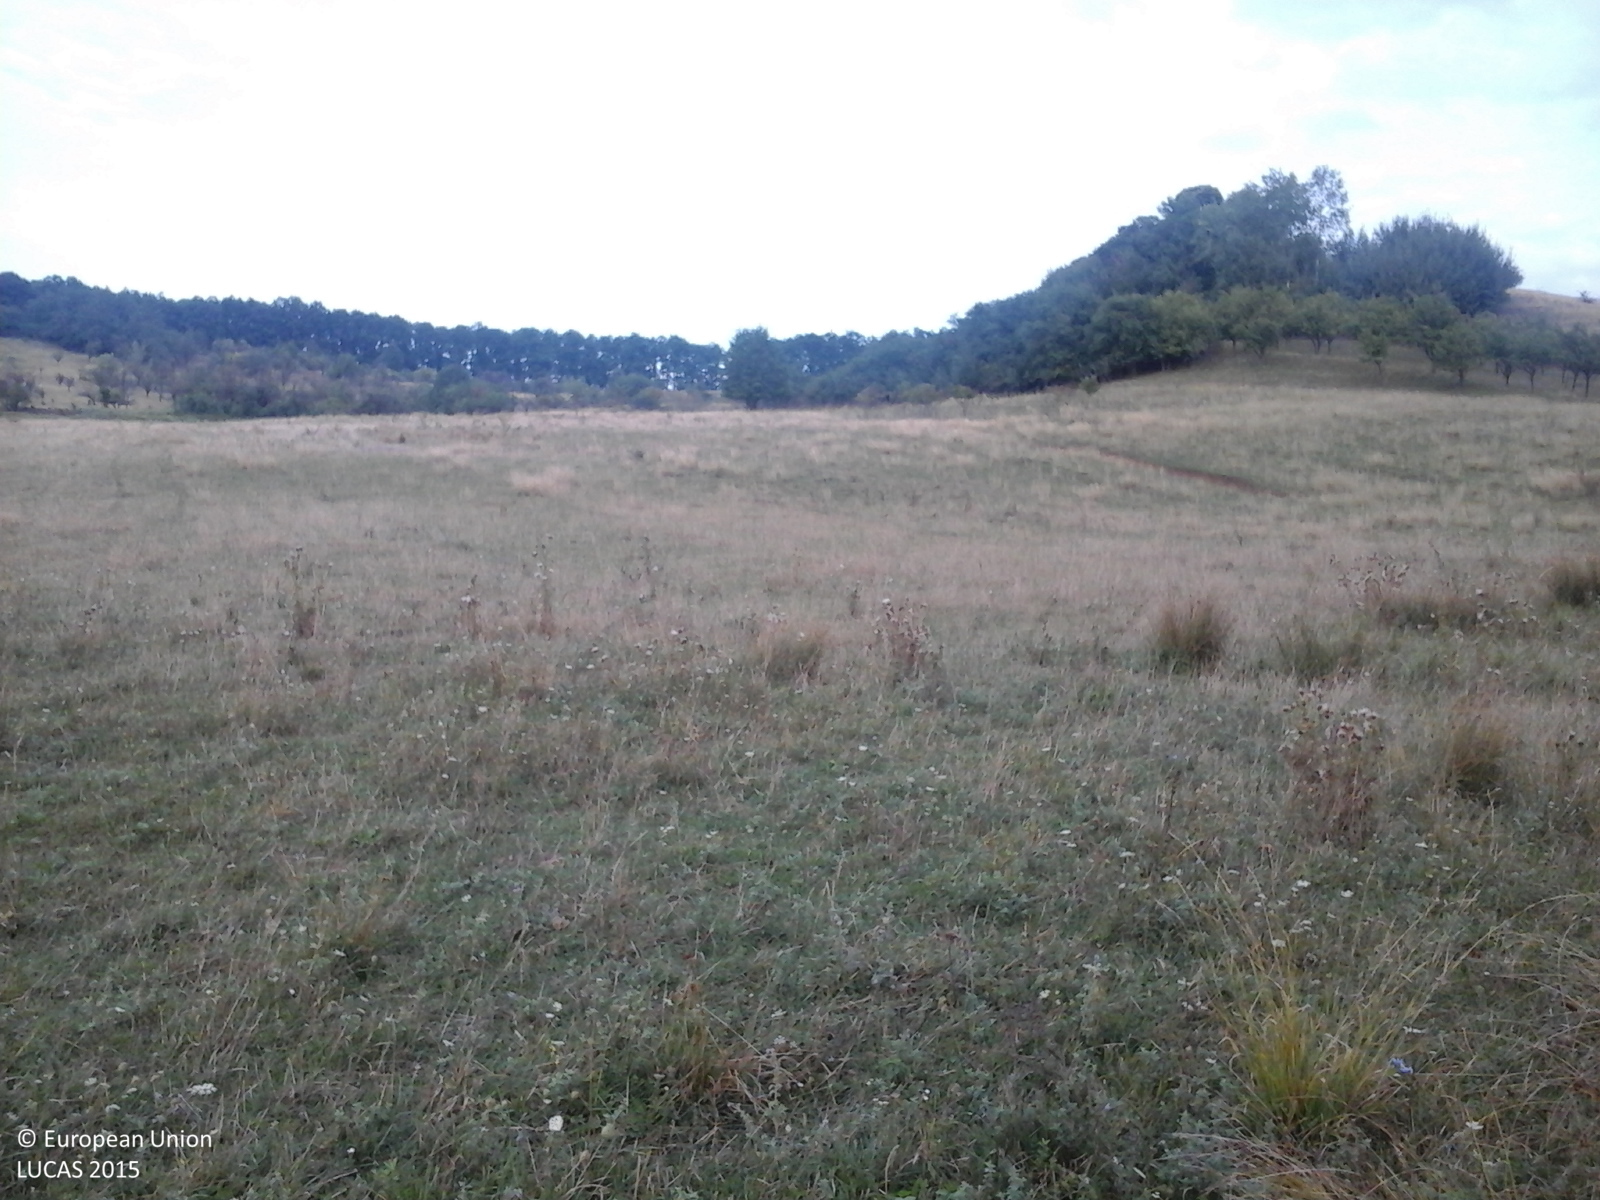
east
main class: Grassland
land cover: Grassland without tree/shrub cover
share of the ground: > 75 %
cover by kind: herbaceous plants 100 %
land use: Agriculture (excluding fallow land and kitchen gardens)
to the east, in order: Grassland without tree/shrub cover; Grassland with sparse tree/shrub cover; Broadleaved woodland; Grassland without tree/shrub cover
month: September
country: RO
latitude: 47.1402
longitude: 22.9981
